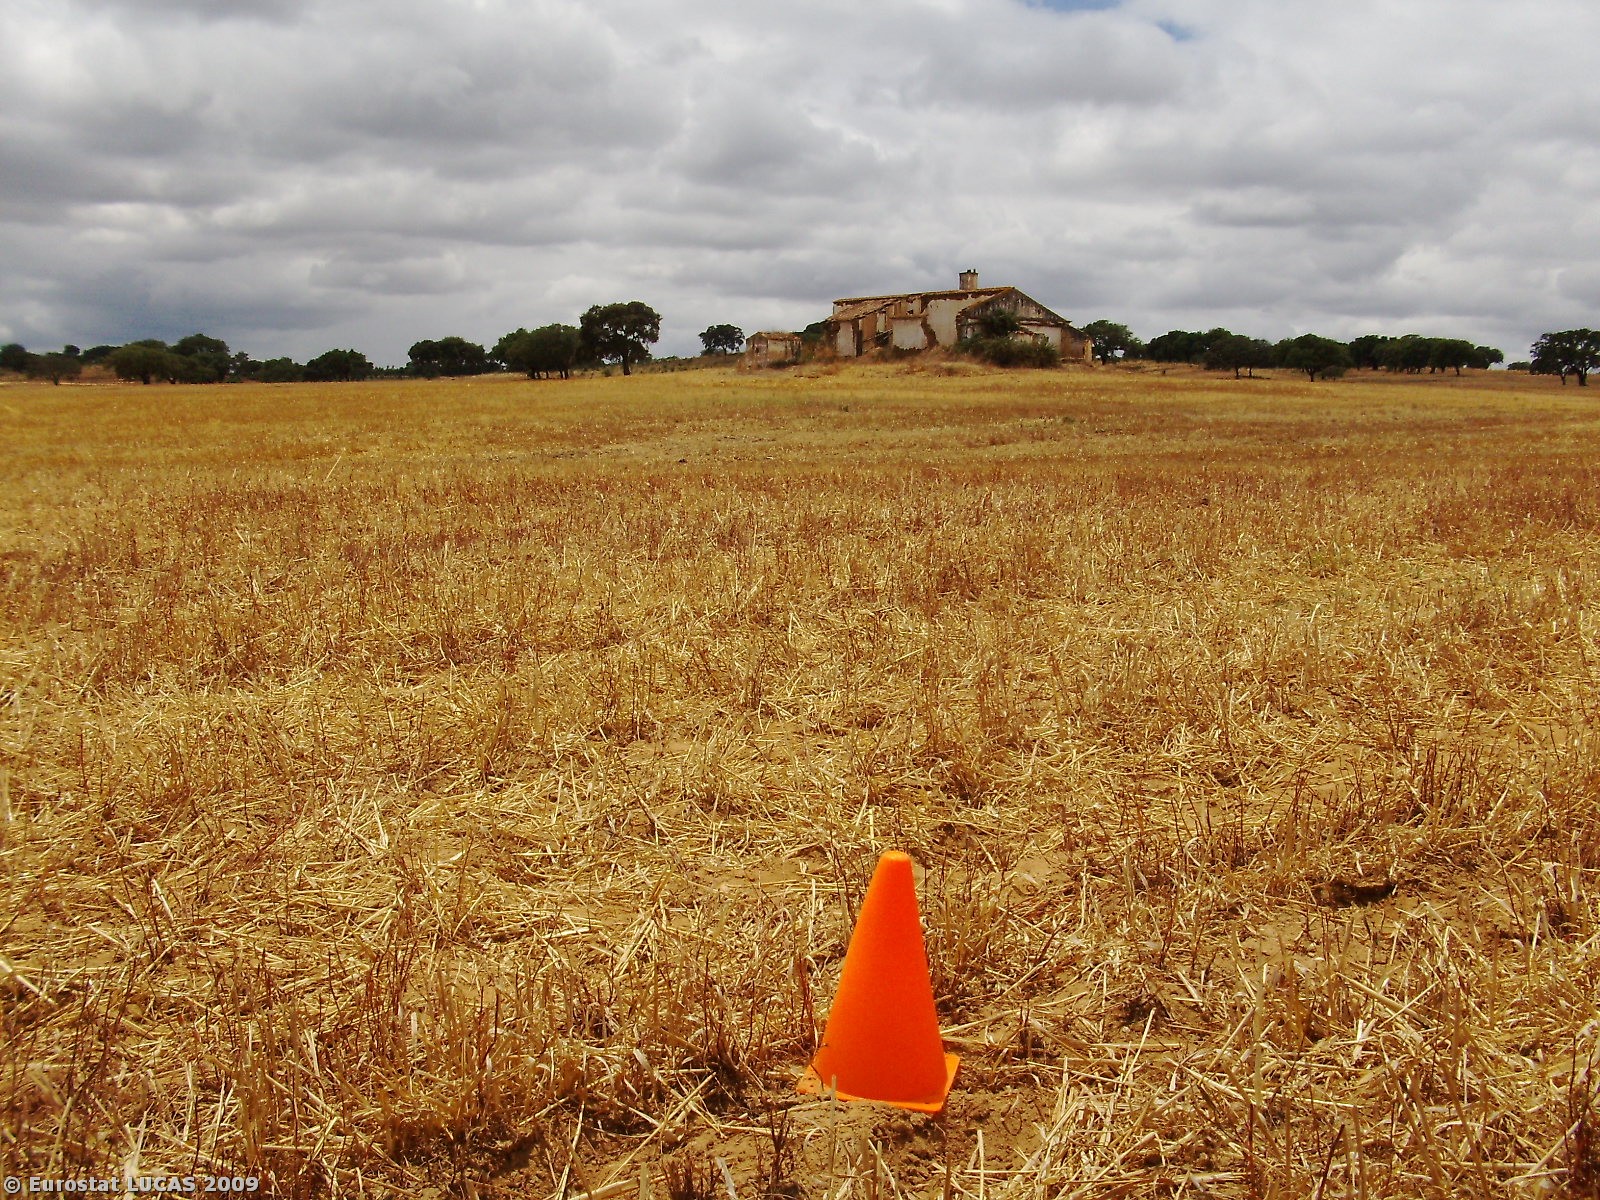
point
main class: Cropland
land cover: Oats
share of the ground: > 75 %
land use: Agriculture (excluding fallow land and kitchen gardens)
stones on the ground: < 10 %
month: June
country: PT
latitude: 37.8721
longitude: -8.4441
